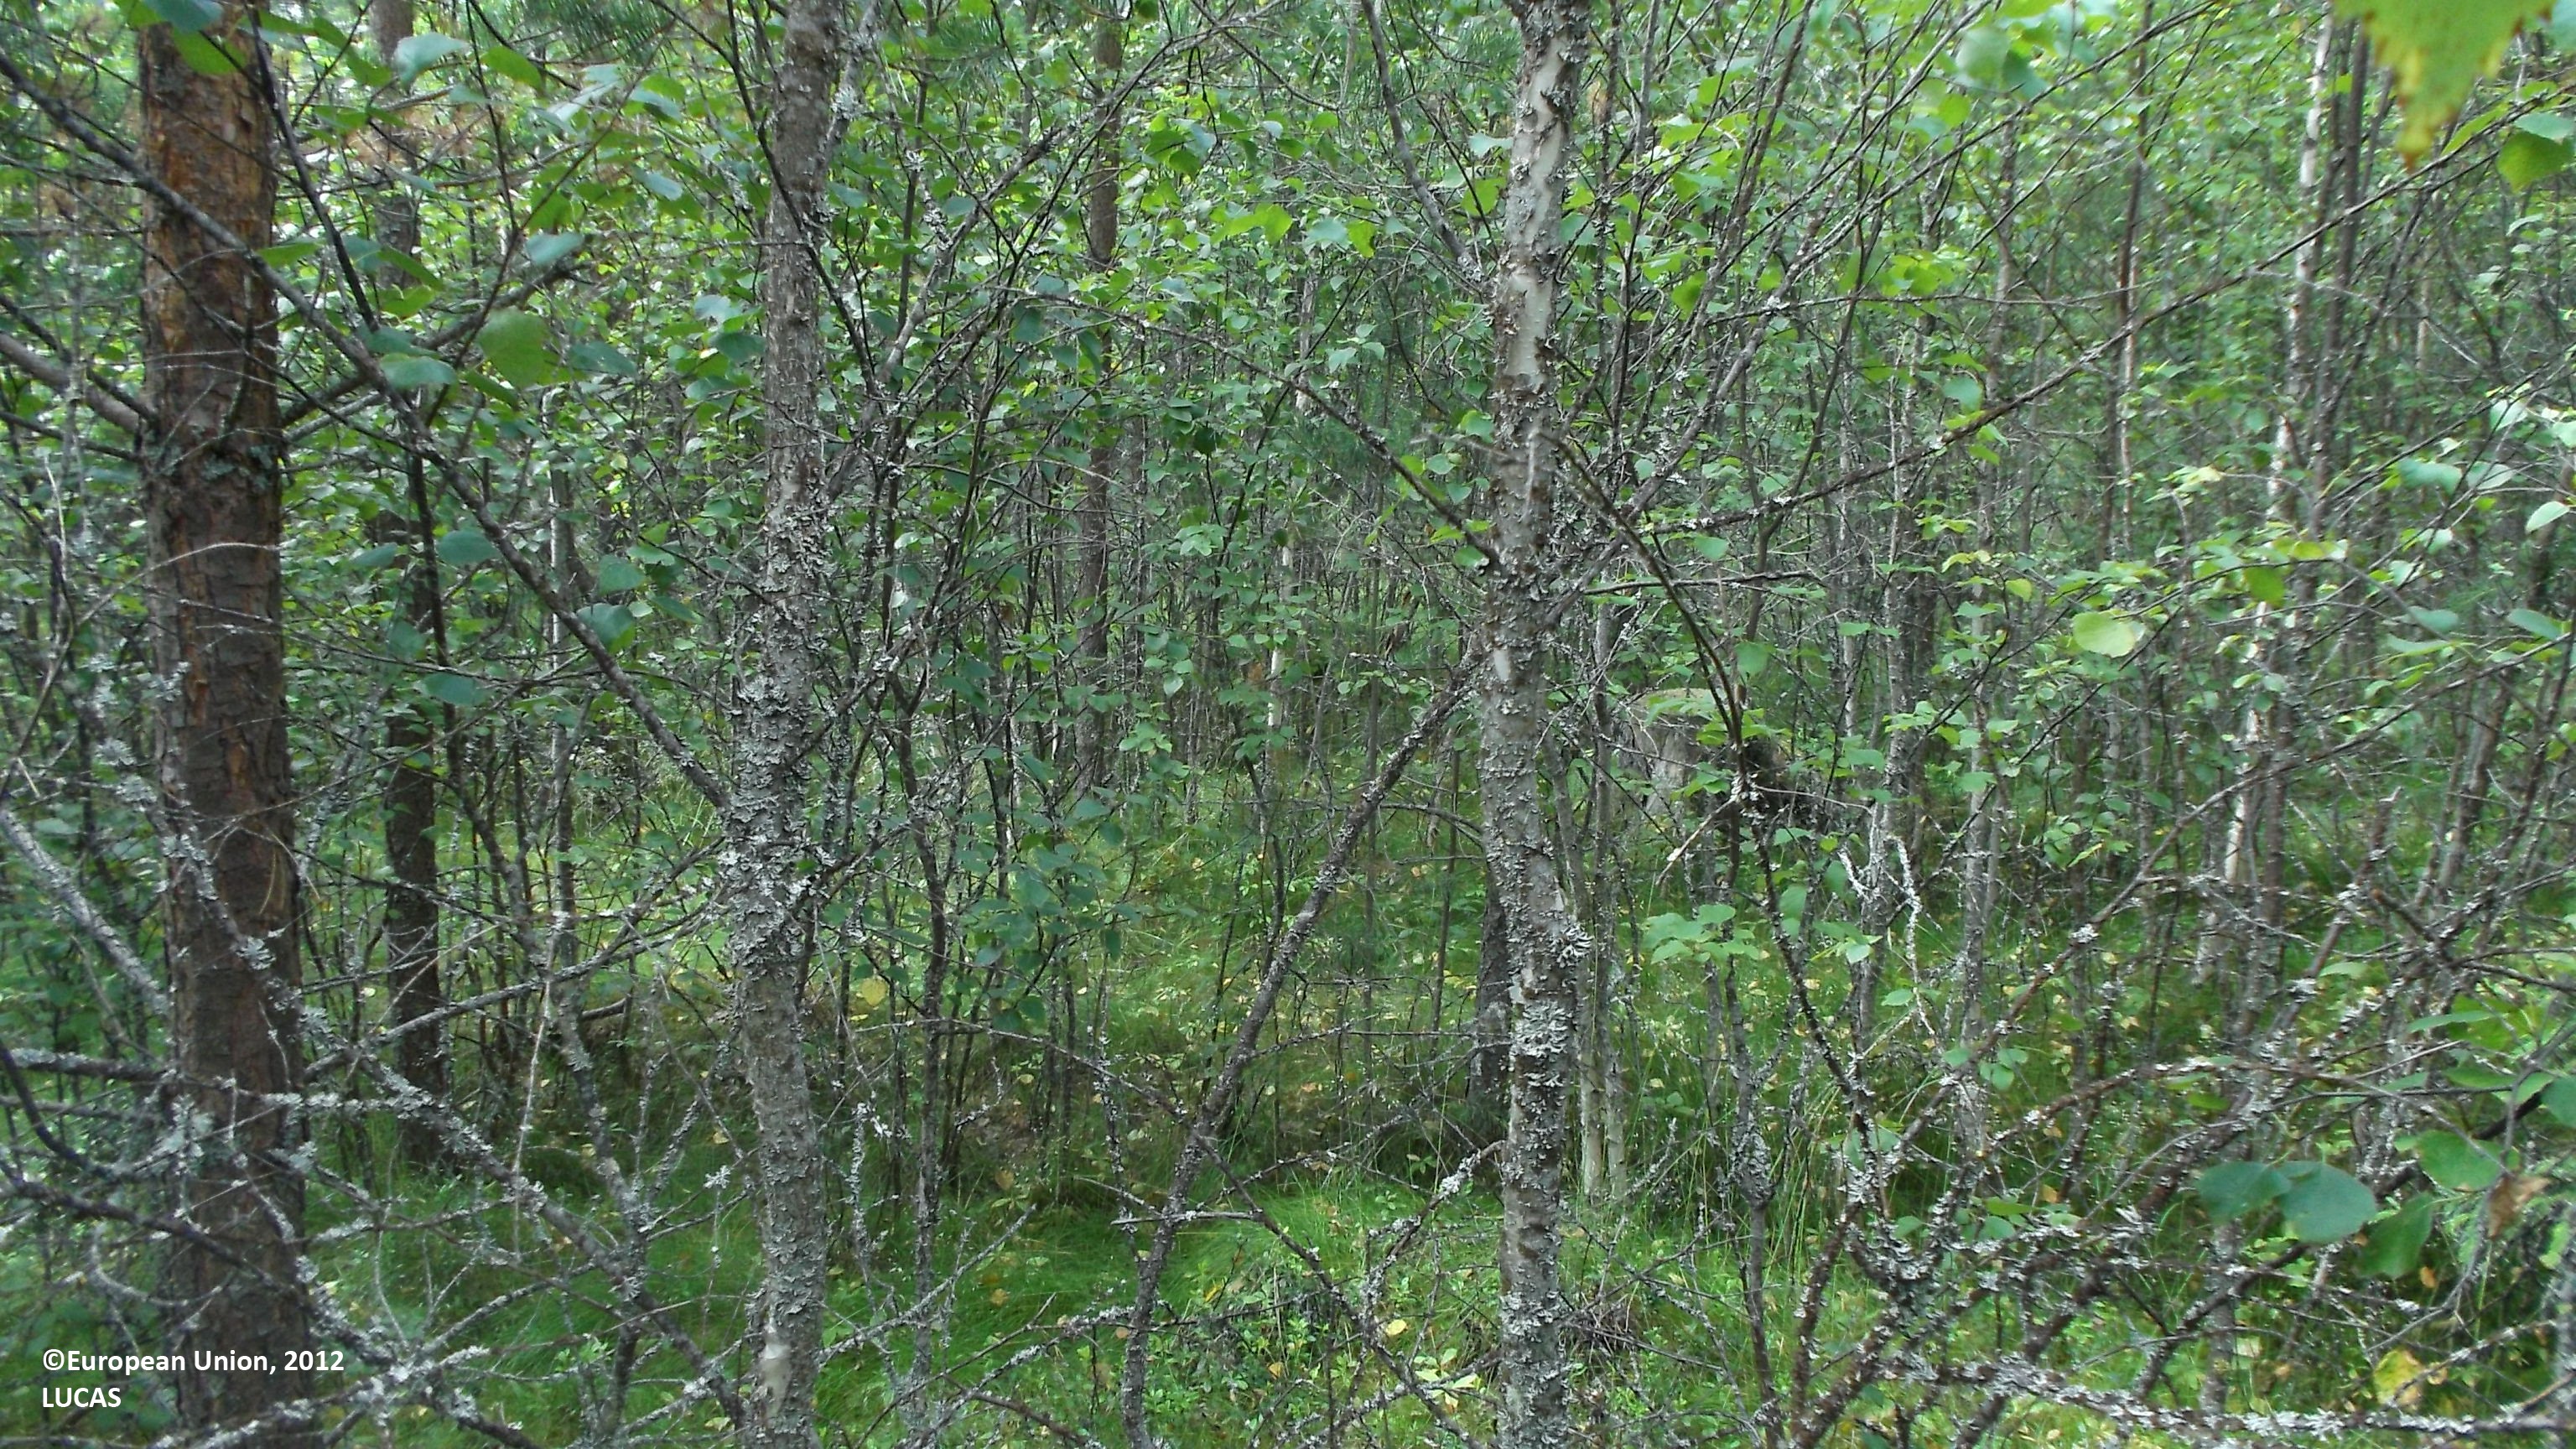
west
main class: Woodland
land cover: Other mixed woodland
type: boreal forest
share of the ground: 50 - 75 %
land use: Forestry
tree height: > 5 m
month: July
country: FI
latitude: 63.6638
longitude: 23.3725
